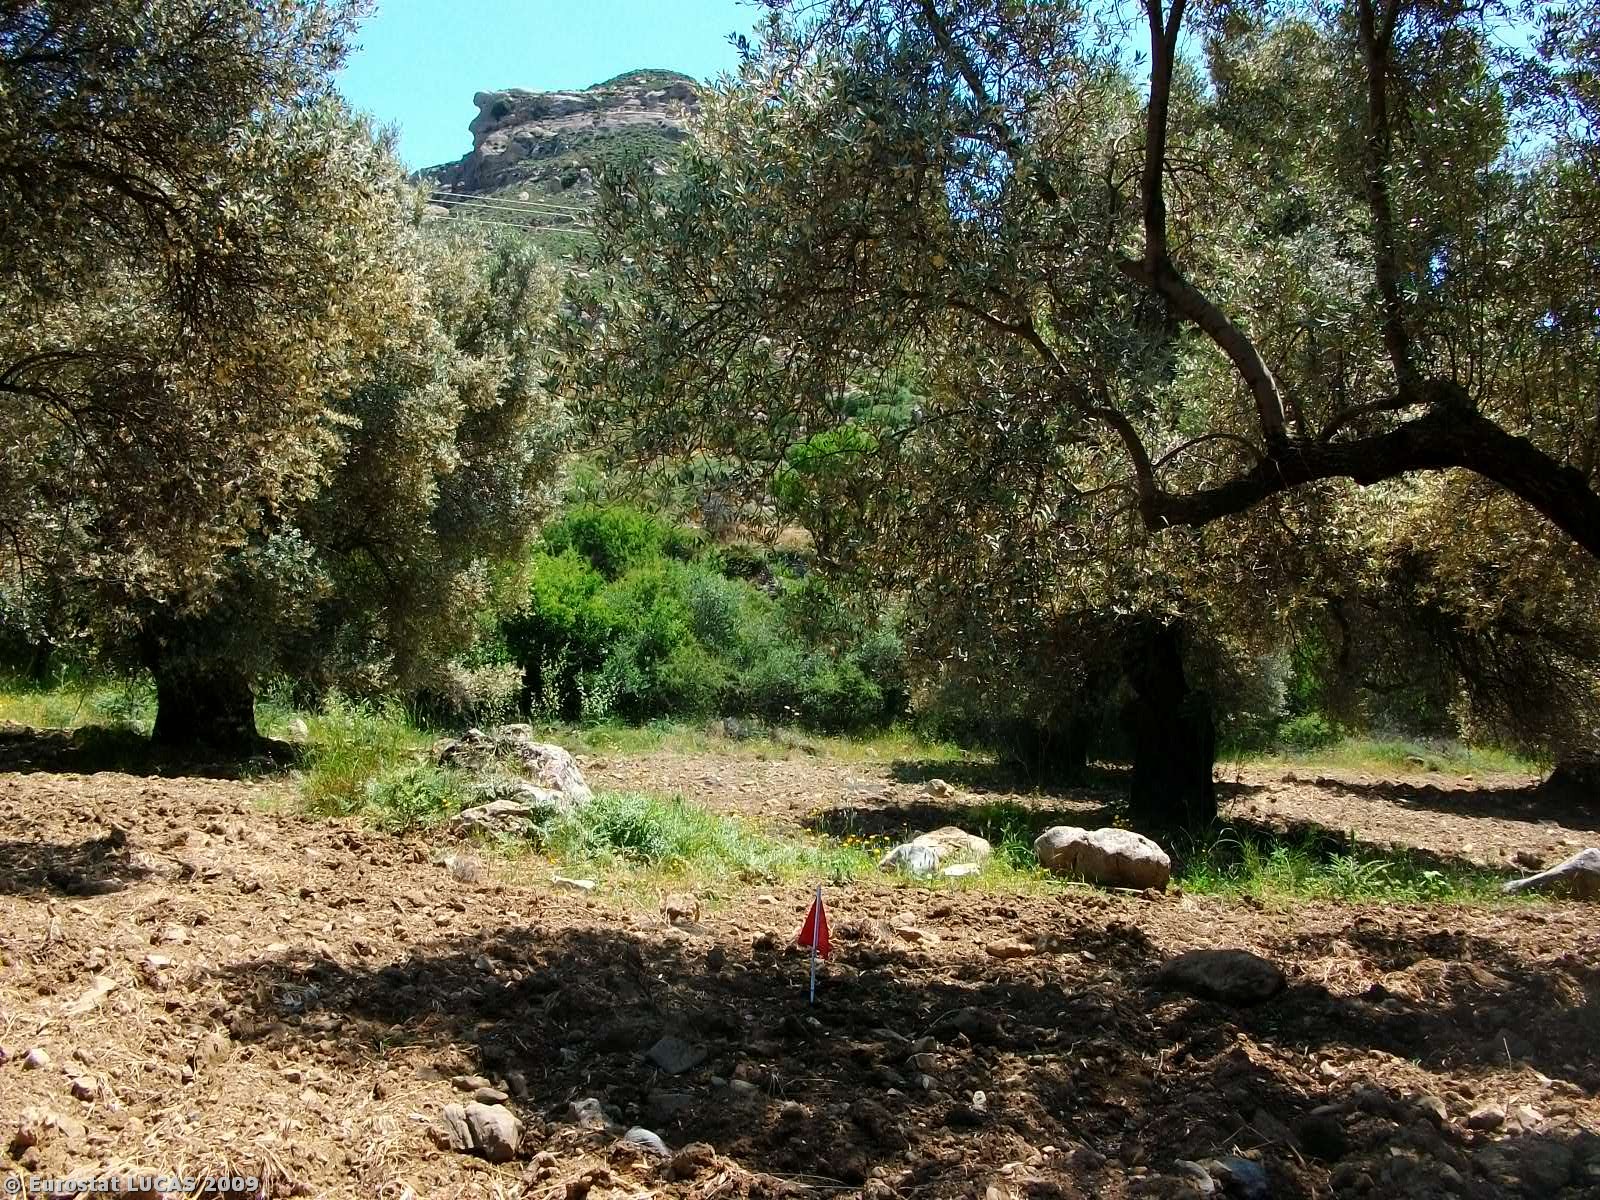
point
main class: Cropland
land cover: Olive groves
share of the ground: > 75 %
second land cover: Bare land
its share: > 75 %
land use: Agriculture (excluding fallow land and kitchen gardens)
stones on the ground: 10 - 25 %
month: May
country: GR
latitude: 35.1368
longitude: 24.9684
